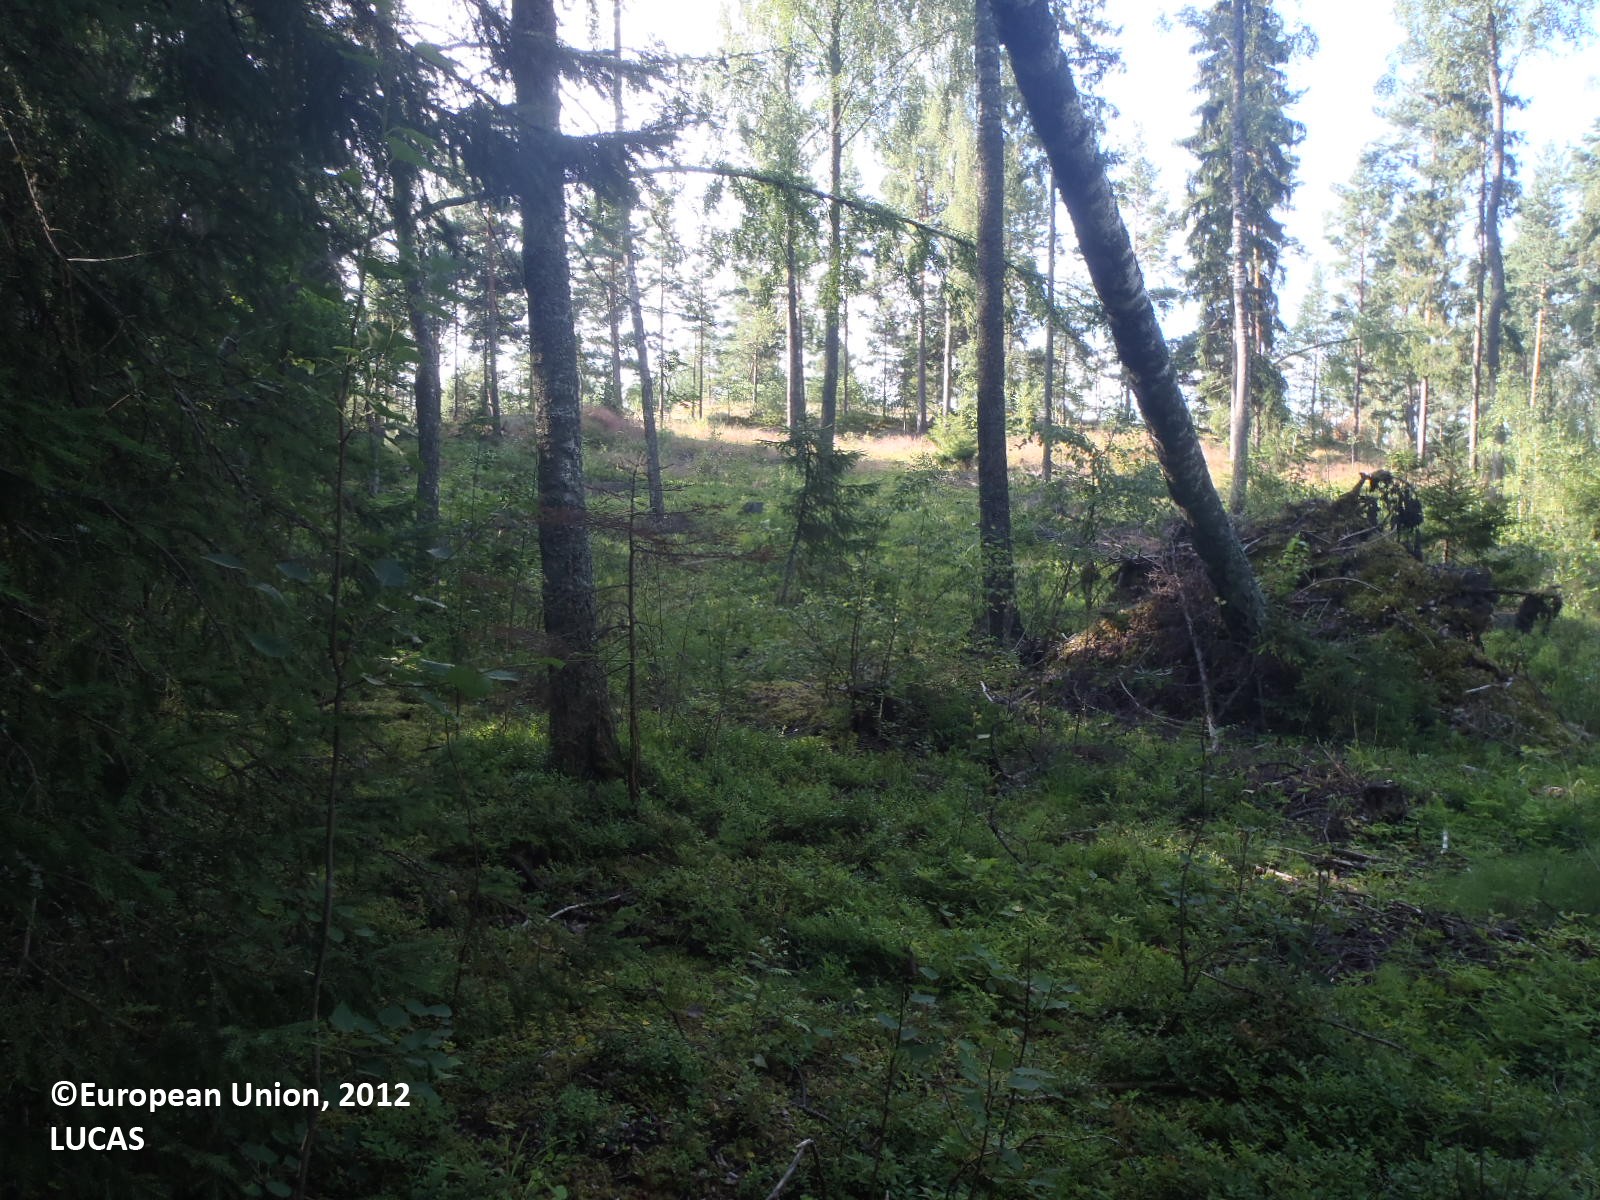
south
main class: Woodland
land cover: Spruce dominated mixed woodland
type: boreal forest
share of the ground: > 75 %
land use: Forestry
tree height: > 5 m
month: July
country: FI
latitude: 60.3724
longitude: 22.2721
